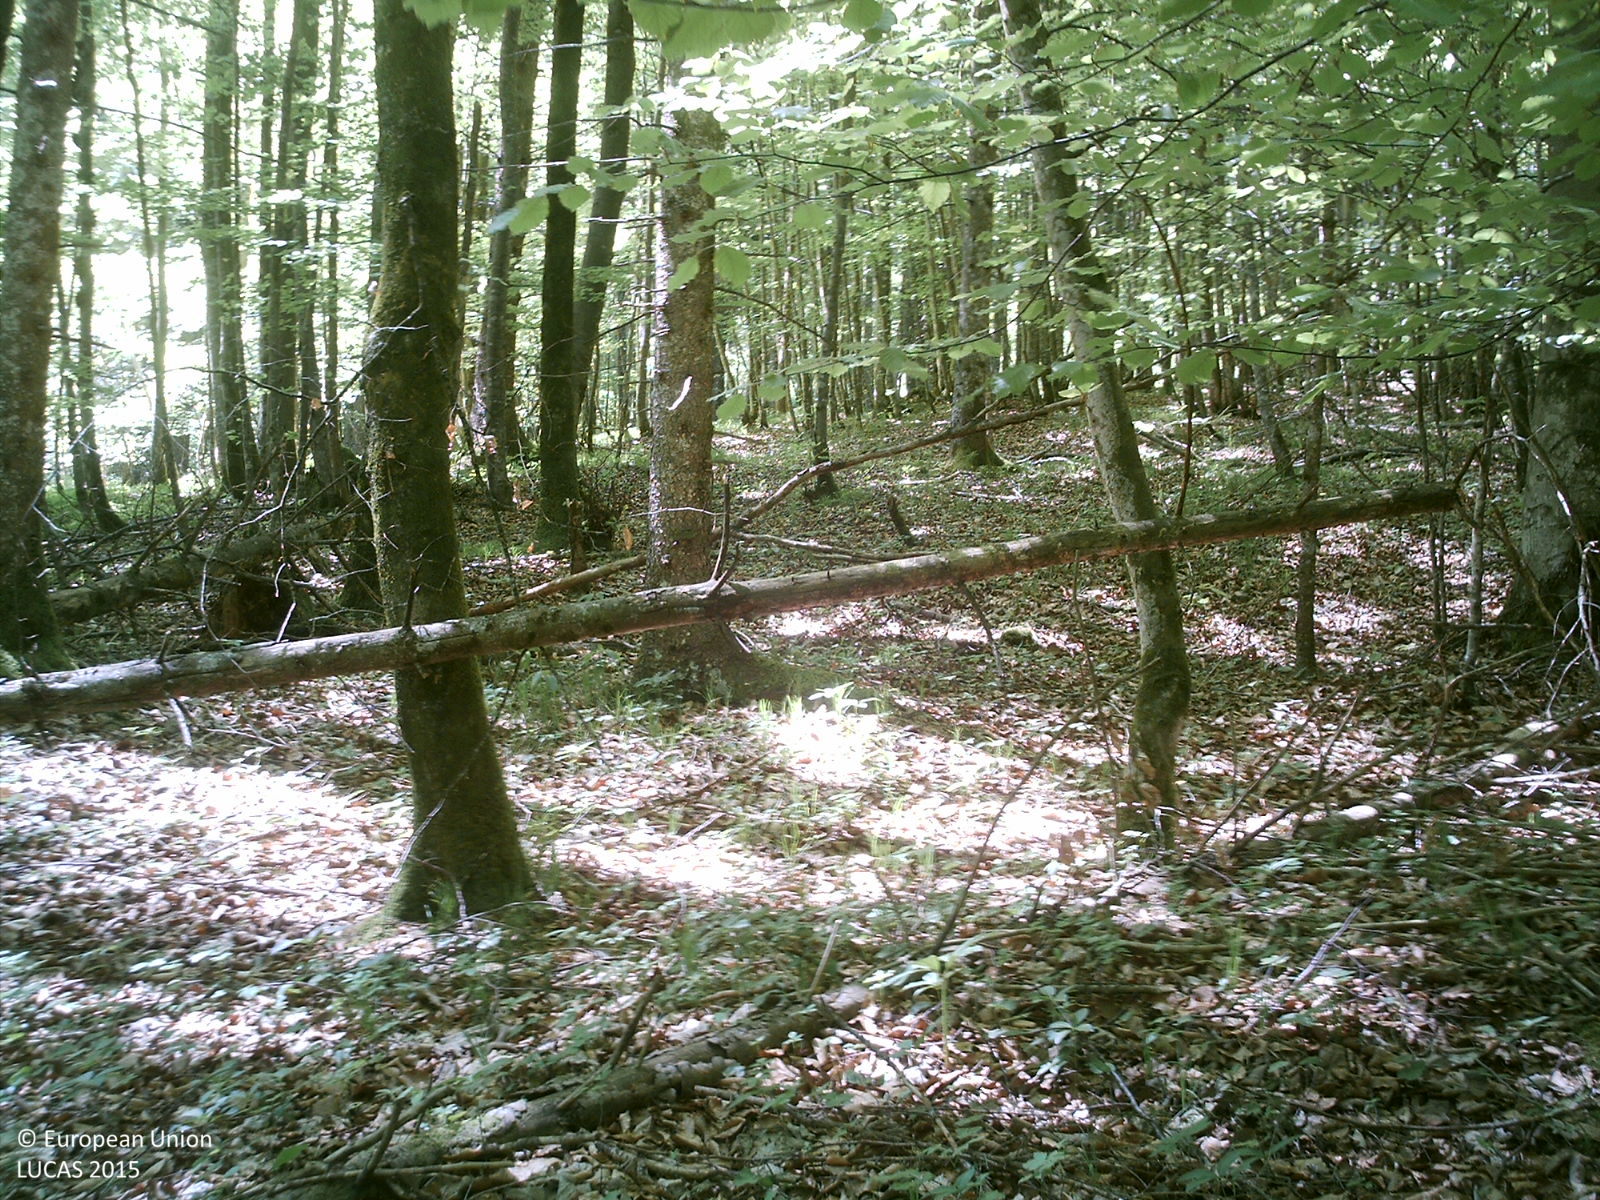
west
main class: Woodland
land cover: Broadleaved woodland
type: mountainous beech forest
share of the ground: > 75 %
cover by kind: broadleaved forest trees 90 %, coniferous forest trees 10 %
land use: Forestry
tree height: > 5 m
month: May
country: AT
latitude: 47.8389
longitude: 14.1547
